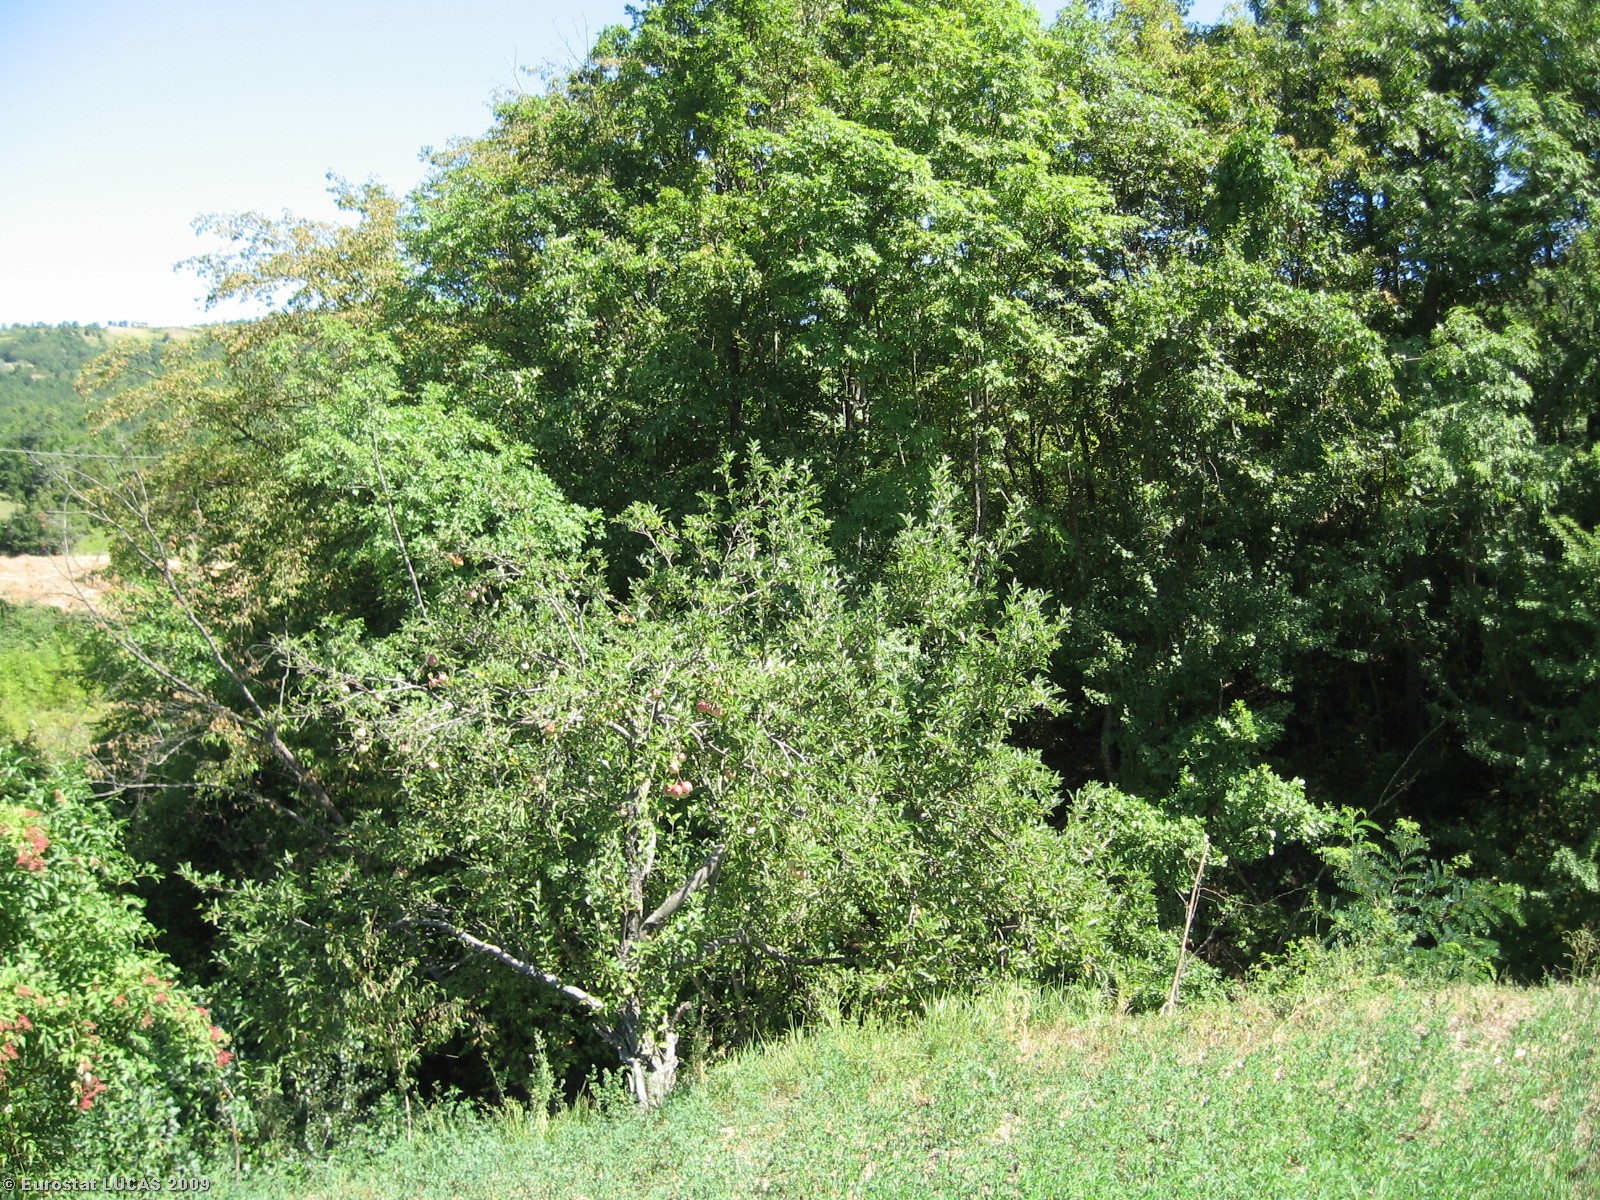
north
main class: Cropland
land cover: Lucerne
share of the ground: 50 - 75 %
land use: Agriculture (excluding fallow land and kitchen gardens)
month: August
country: IT
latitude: 44.7823
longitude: 9.5334
